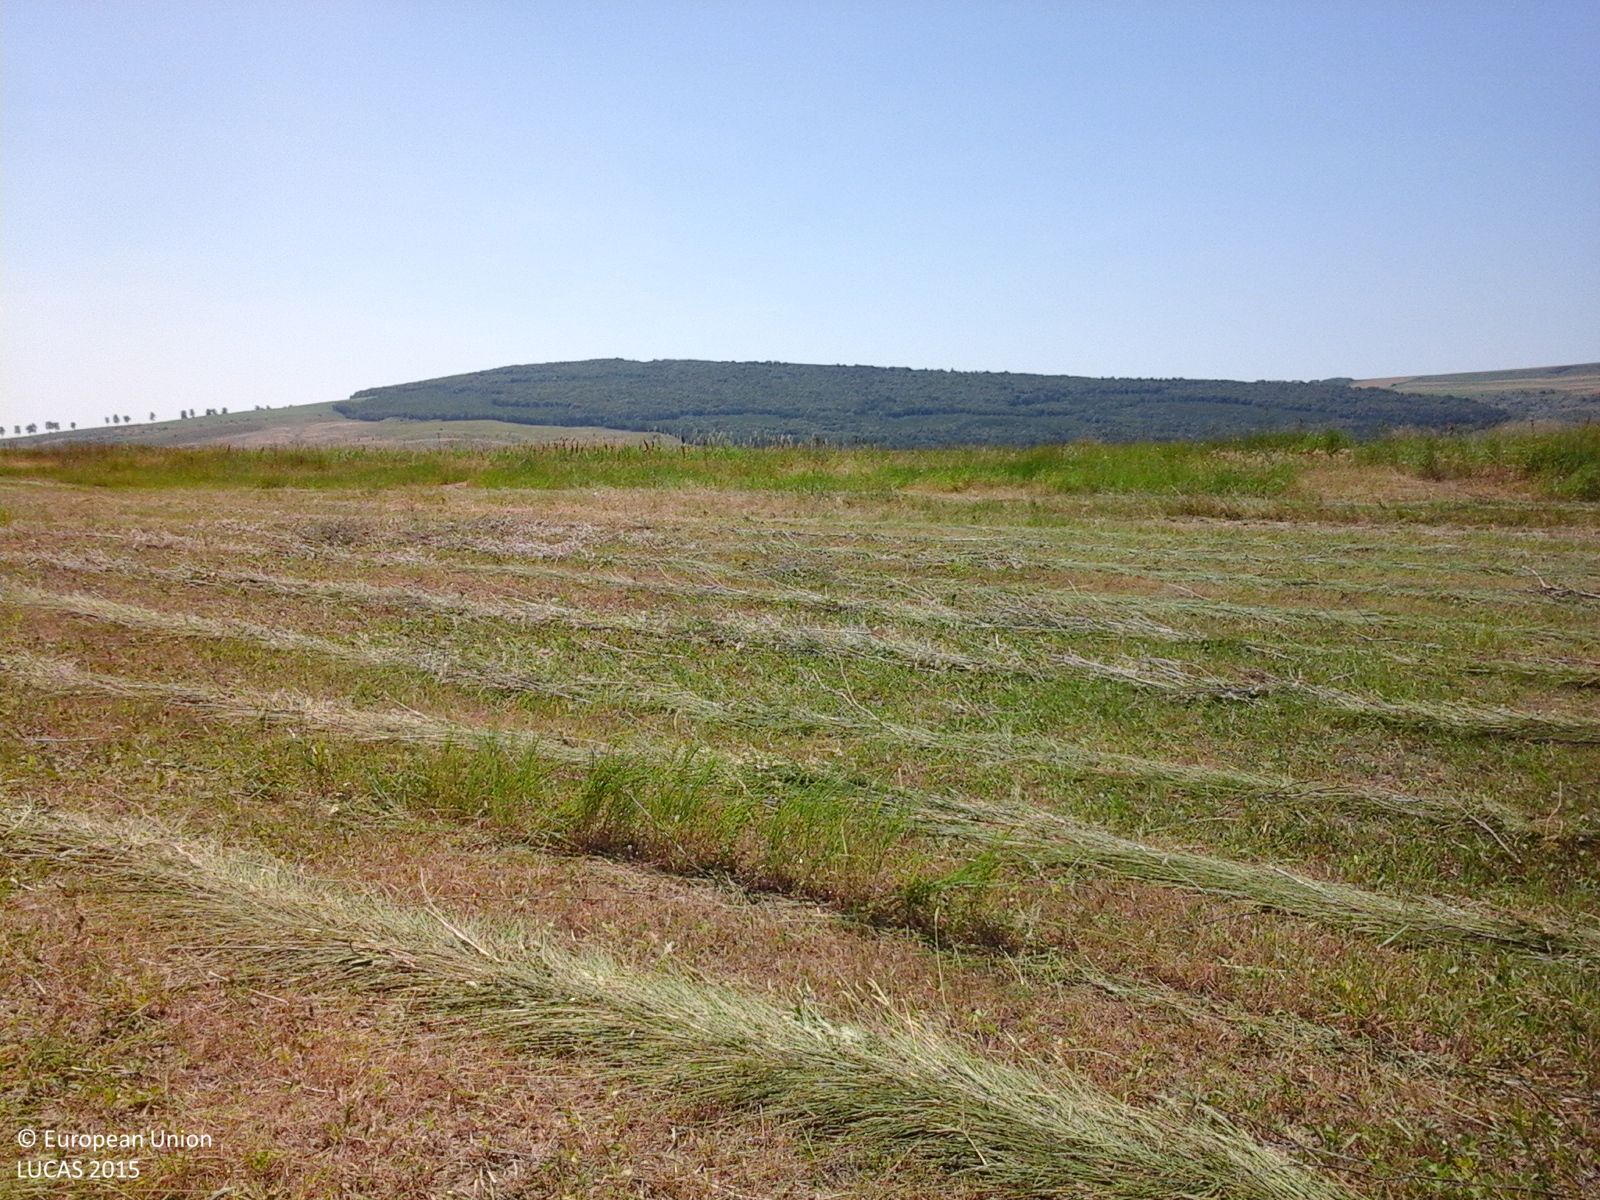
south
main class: Grassland
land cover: Grassland without tree/shrub cover
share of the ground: > 75 %
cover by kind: herbaceous plants 100 %
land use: Agriculture (excluding fallow land and kitchen gardens)
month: June
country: RO
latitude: 47.0012
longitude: 28.0034
